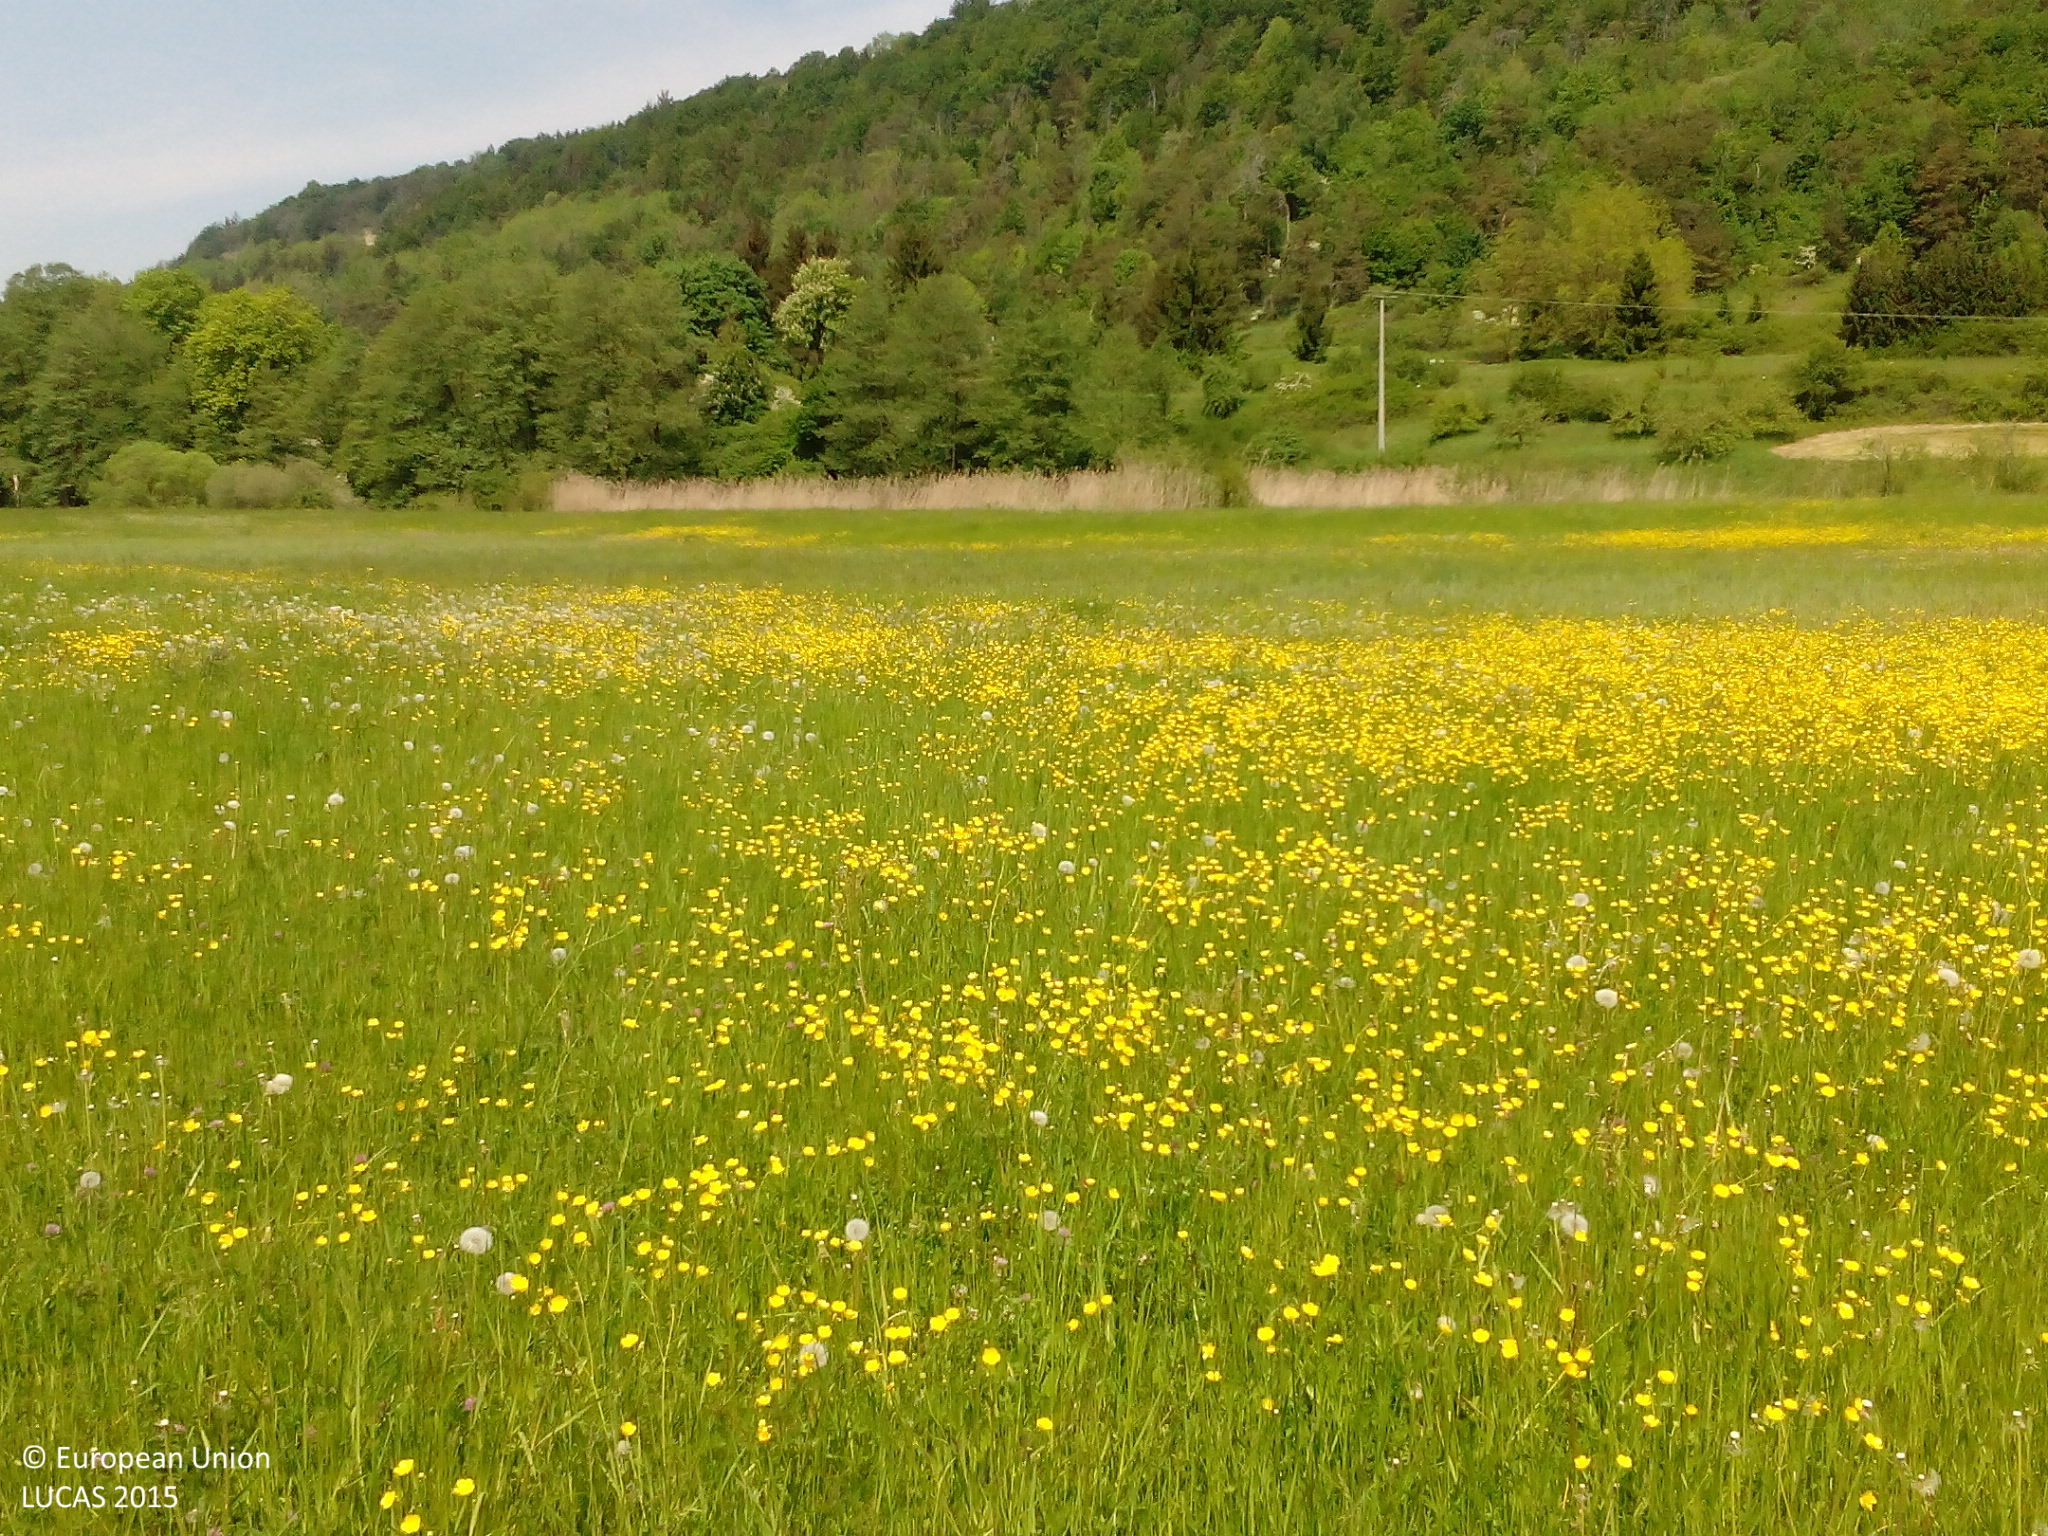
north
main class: Grassland
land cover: Grassland without tree/shrub cover
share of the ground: > 75 %
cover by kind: herbaceous plants 95 %, lichens and mosses 5 %
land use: Agriculture (excluding fallow land and kitchen gardens)
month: May
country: DE
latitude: 49.0232
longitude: 11.4900
